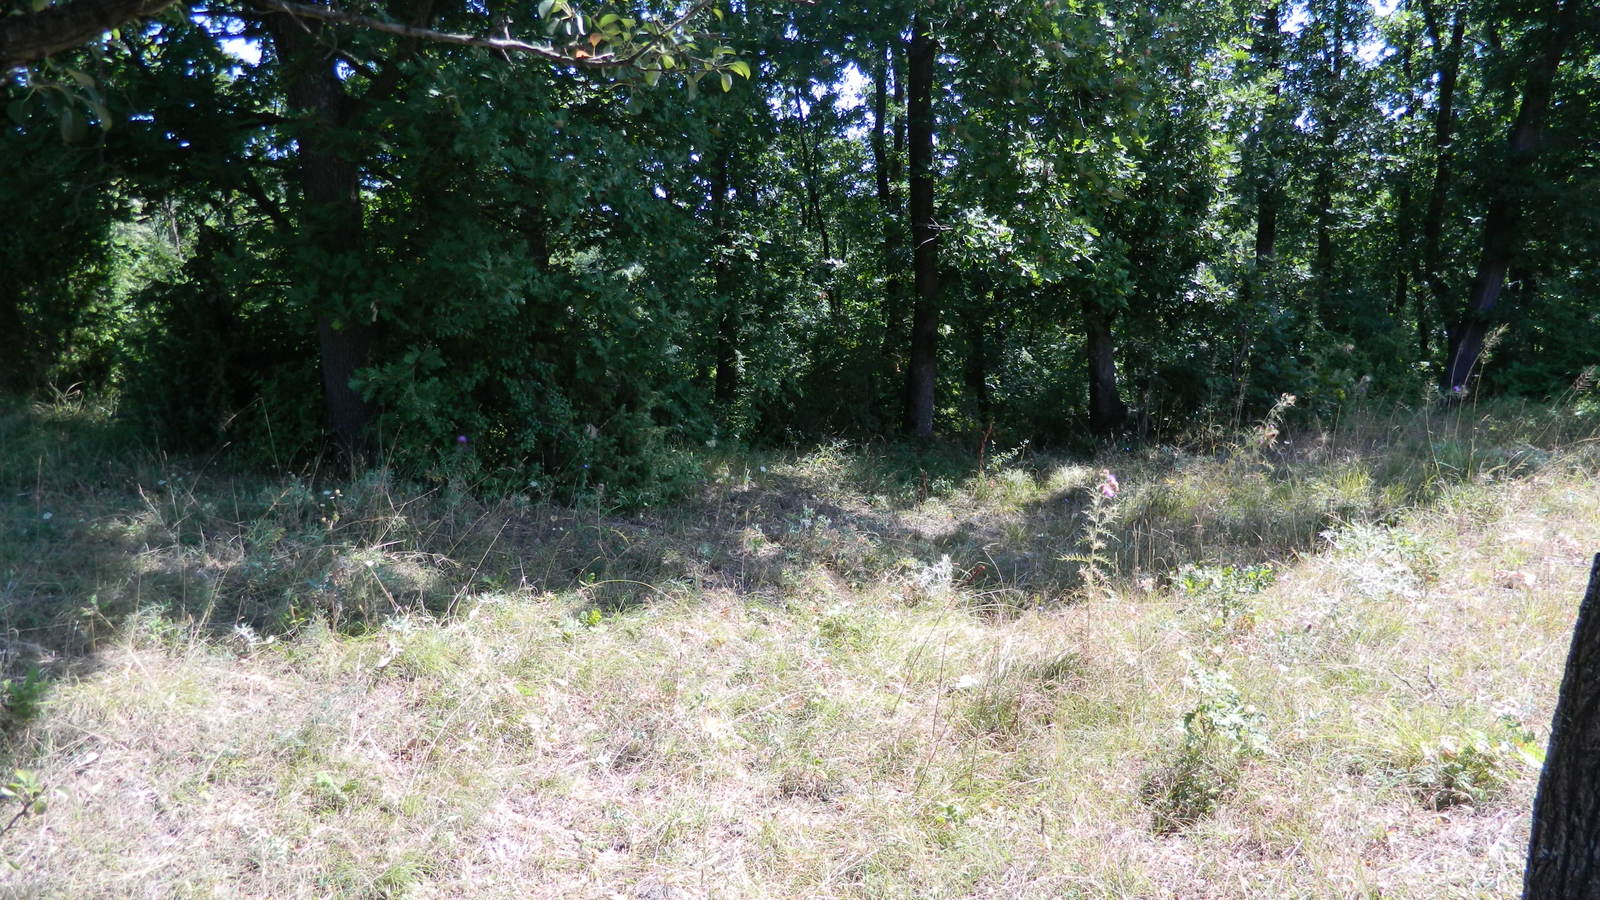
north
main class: Woodland
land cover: Broadleaved woodland
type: mesophytic deciduous forest
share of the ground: > 75 %
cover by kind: broadleaved forest trees 95 %, shrubs 5 %
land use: Forestry
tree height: > 5 m
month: August
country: BG
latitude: 41.6893
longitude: 25.7439
